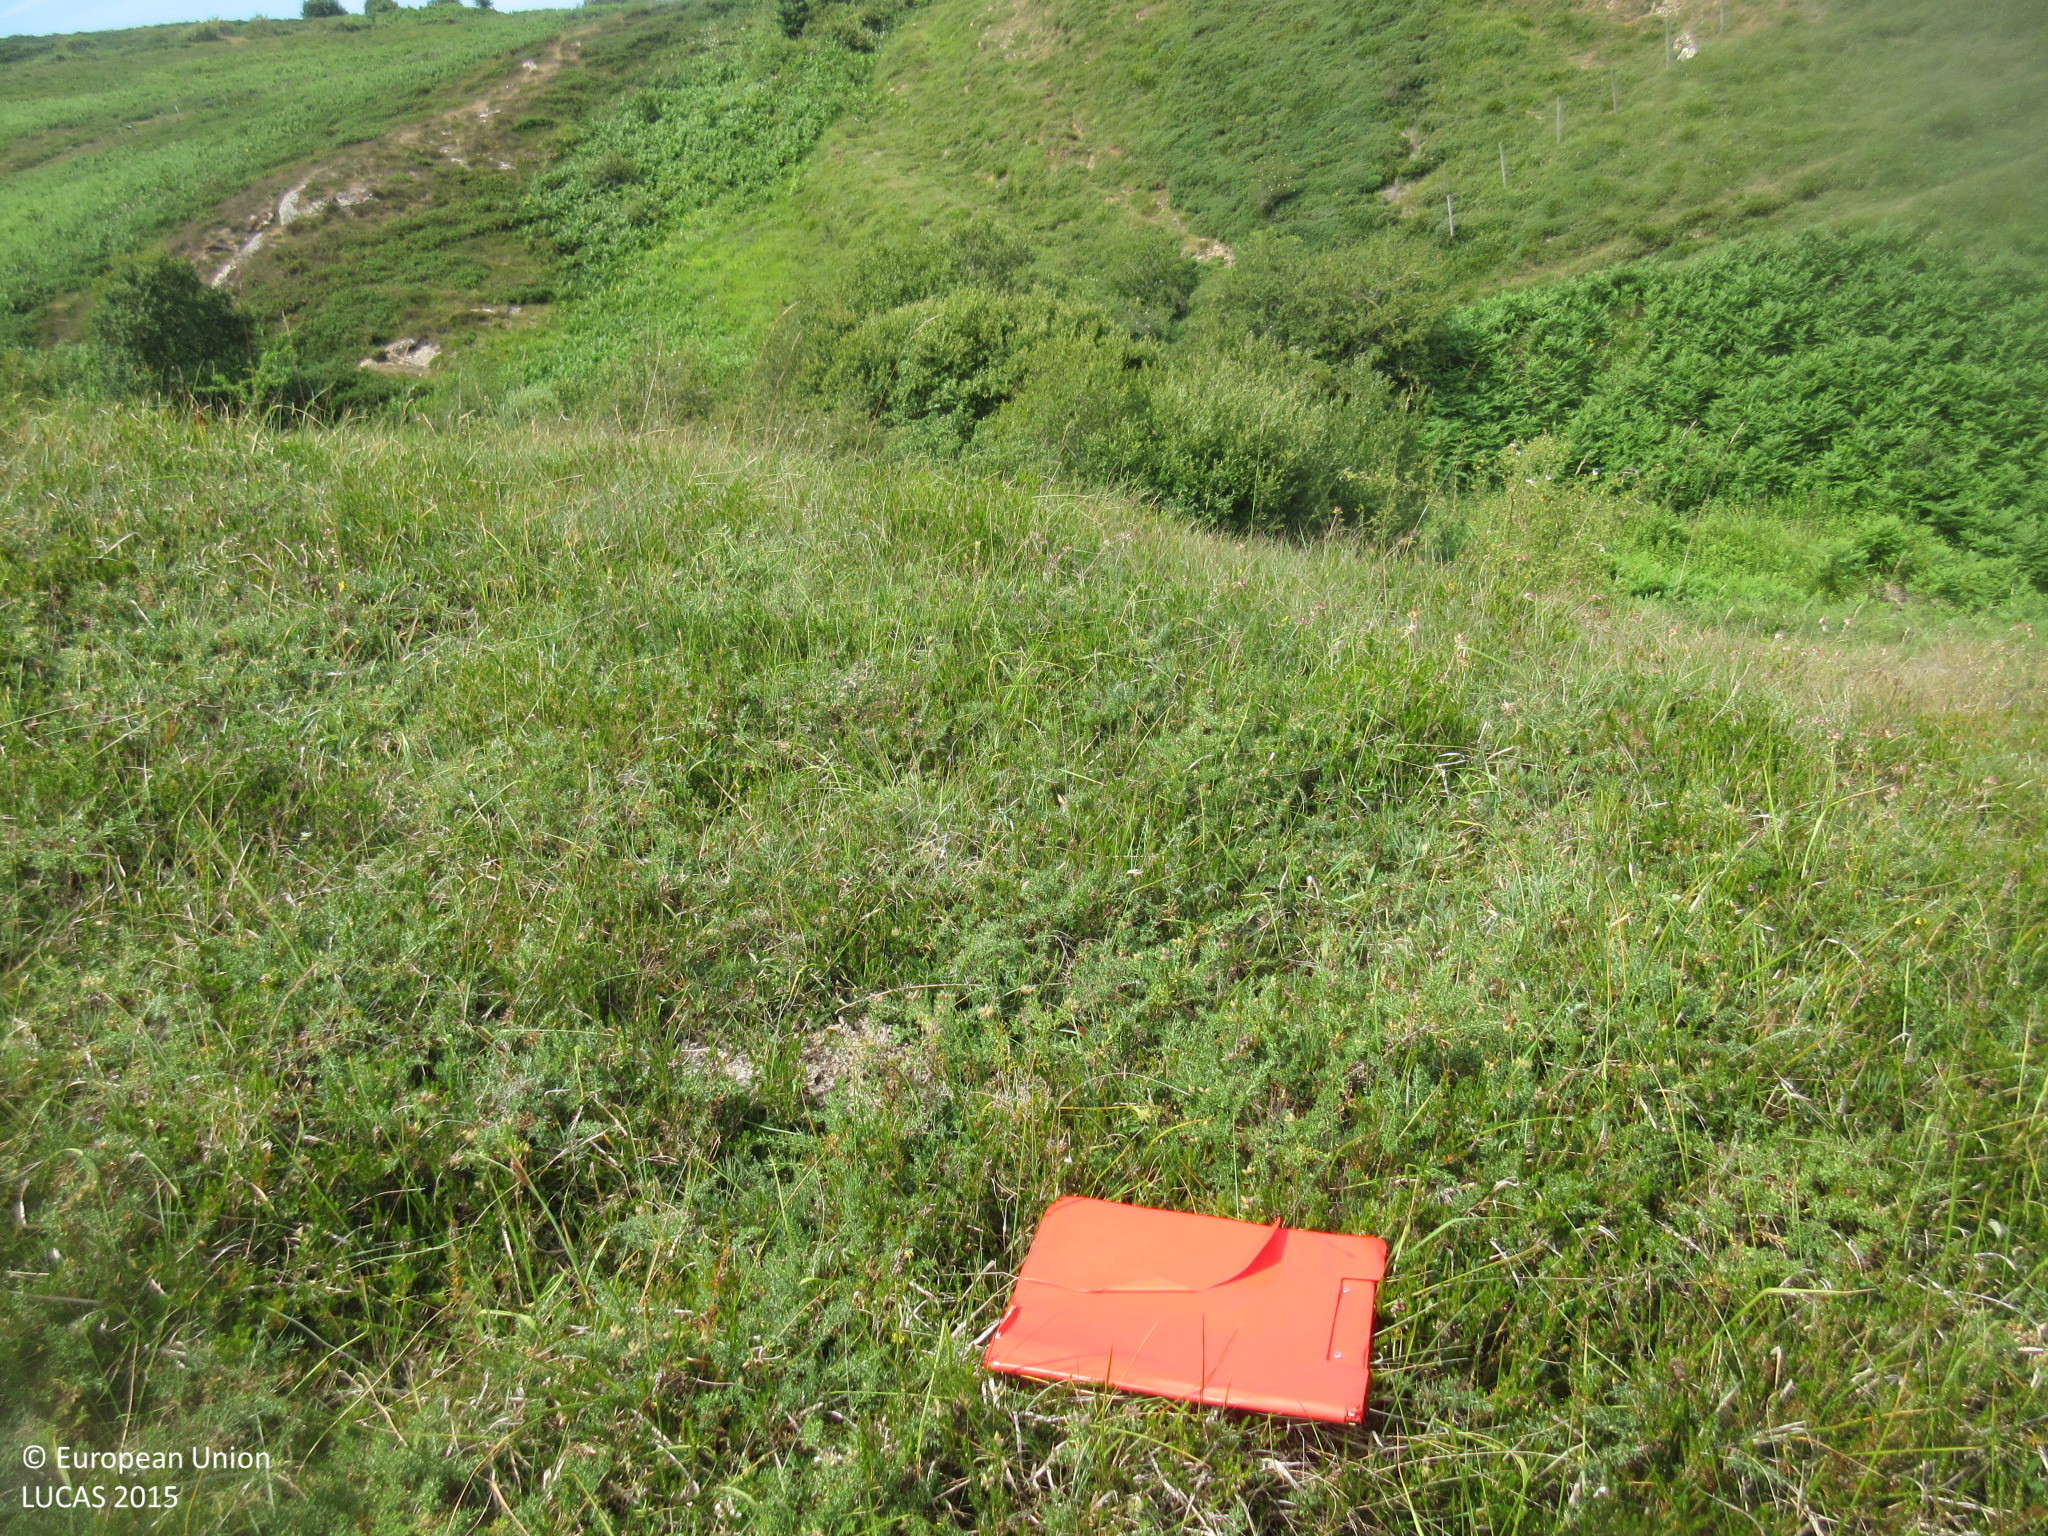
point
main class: Shrubland
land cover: Shrubland without tree cover
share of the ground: 50 - 75 %
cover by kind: shrubs 70 %, herbaceous plants 30 %
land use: Agriculture (excluding fallow land and kitchen gardens)
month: July
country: ES
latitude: 42.9701
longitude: -4.0377
